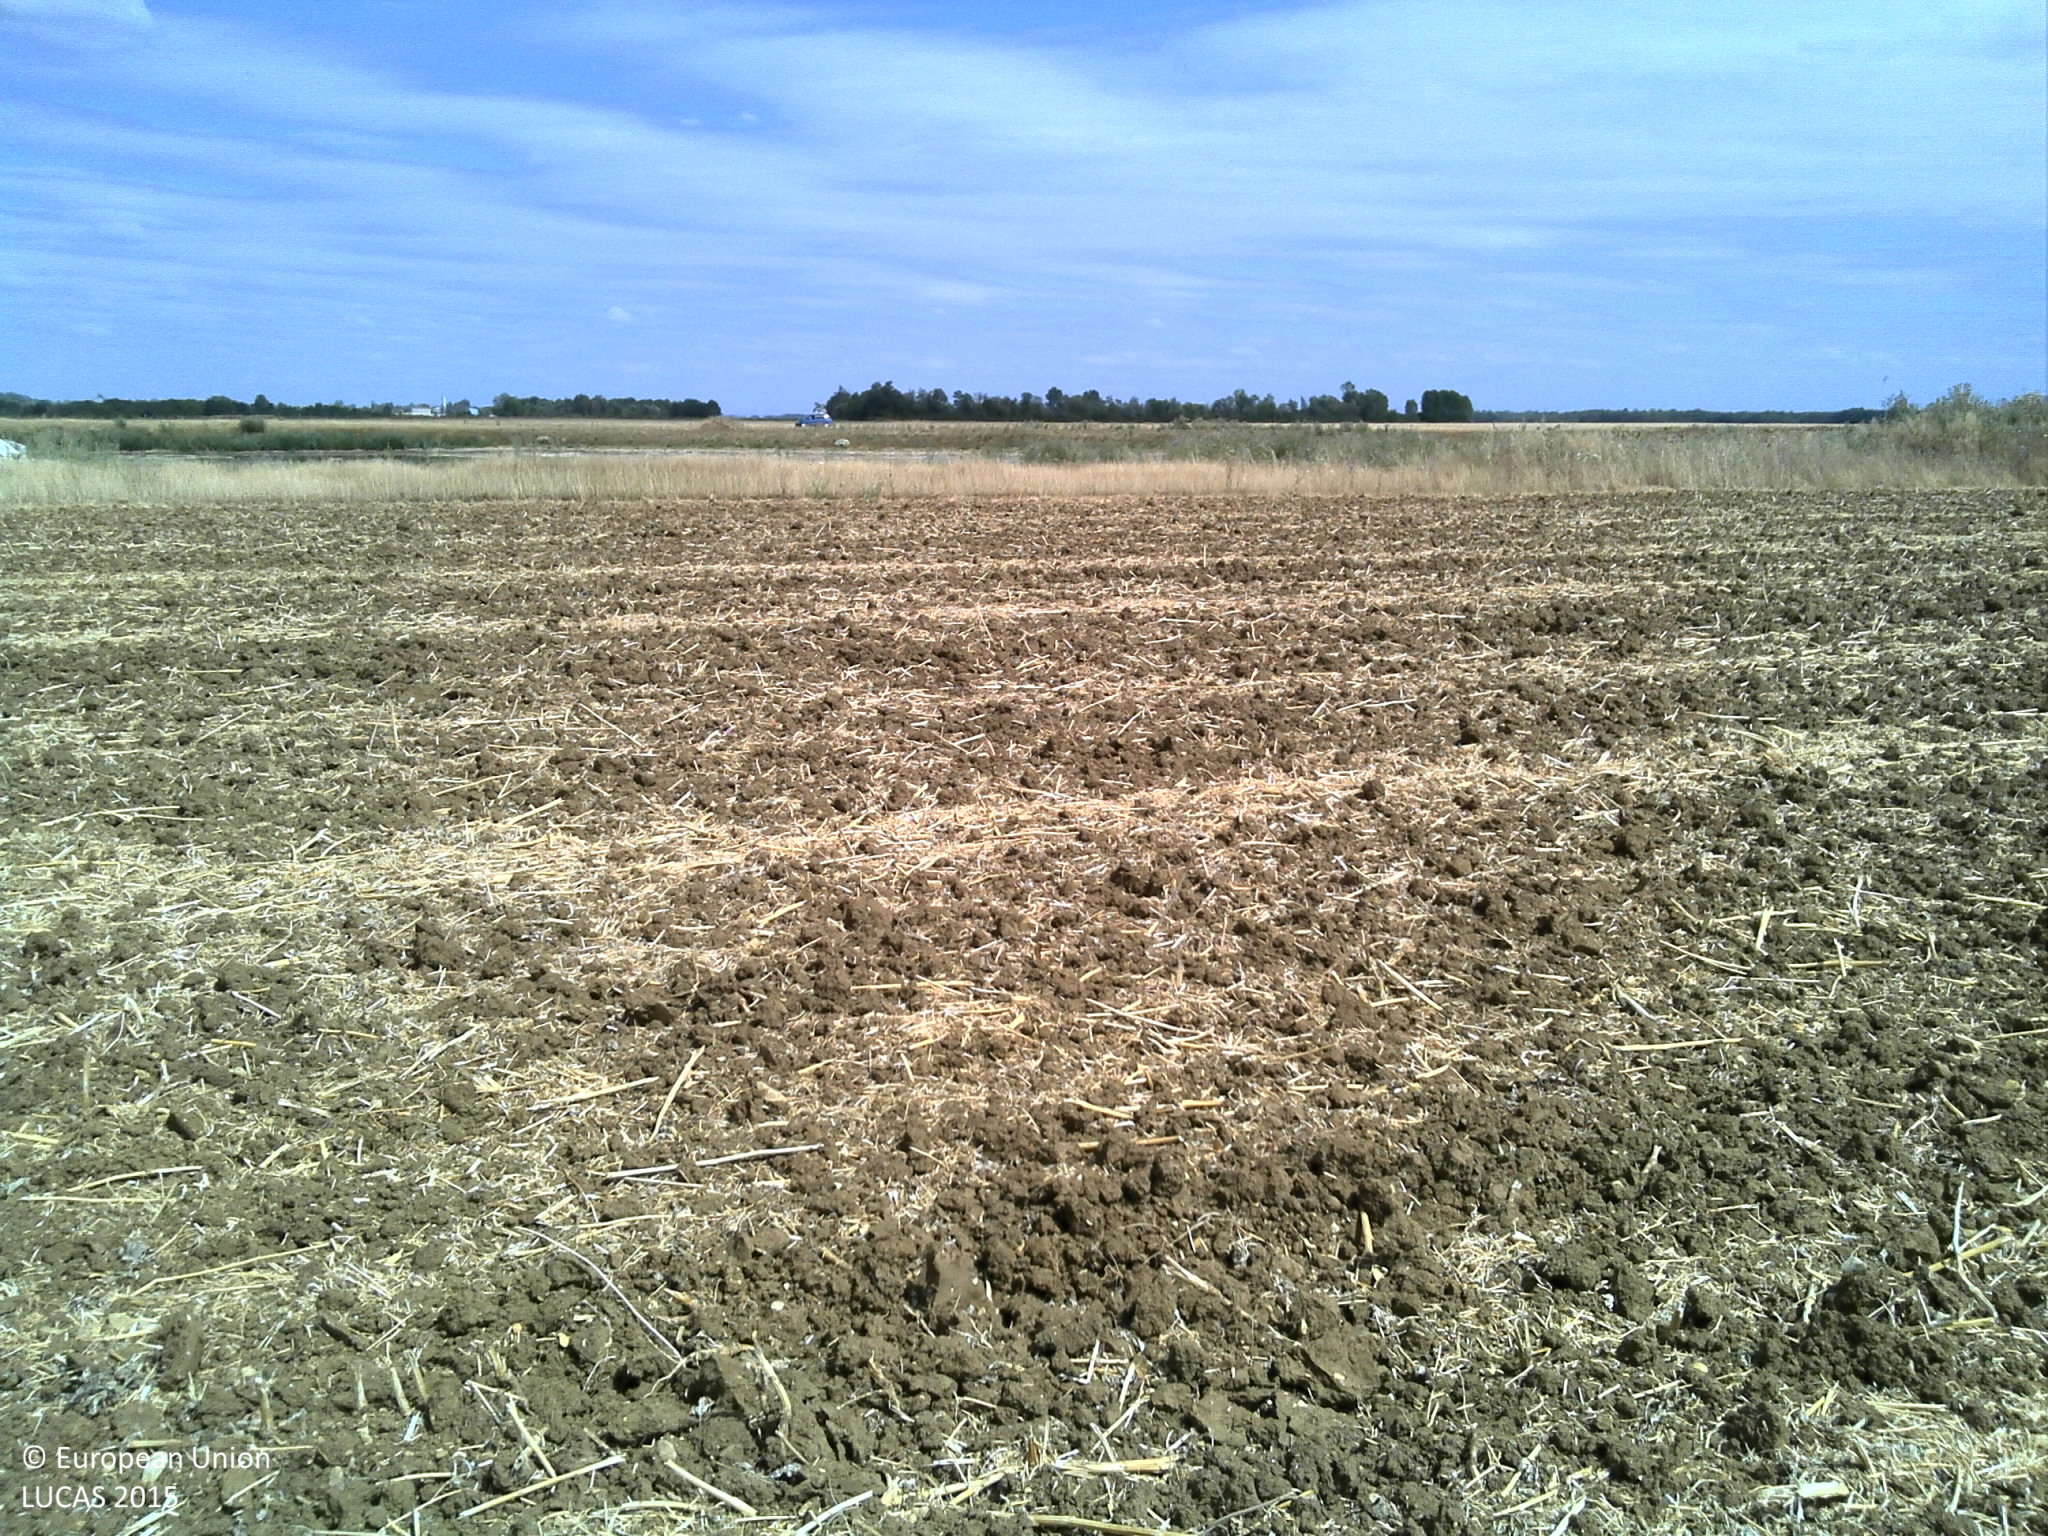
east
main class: Cropland
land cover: Rape and turnip rape
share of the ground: > 75 %
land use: Agriculture (excluding fallow land and kitchen gardens)
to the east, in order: Rape and turnip rape; Spontaneously vegetated surfaces; Sand; Inland fresh water bodies; Spontaneously vegetated surfaces; Tracks; Grass margins; Other bare soil
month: July
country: FR
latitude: 48.6546
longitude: 4.6897
